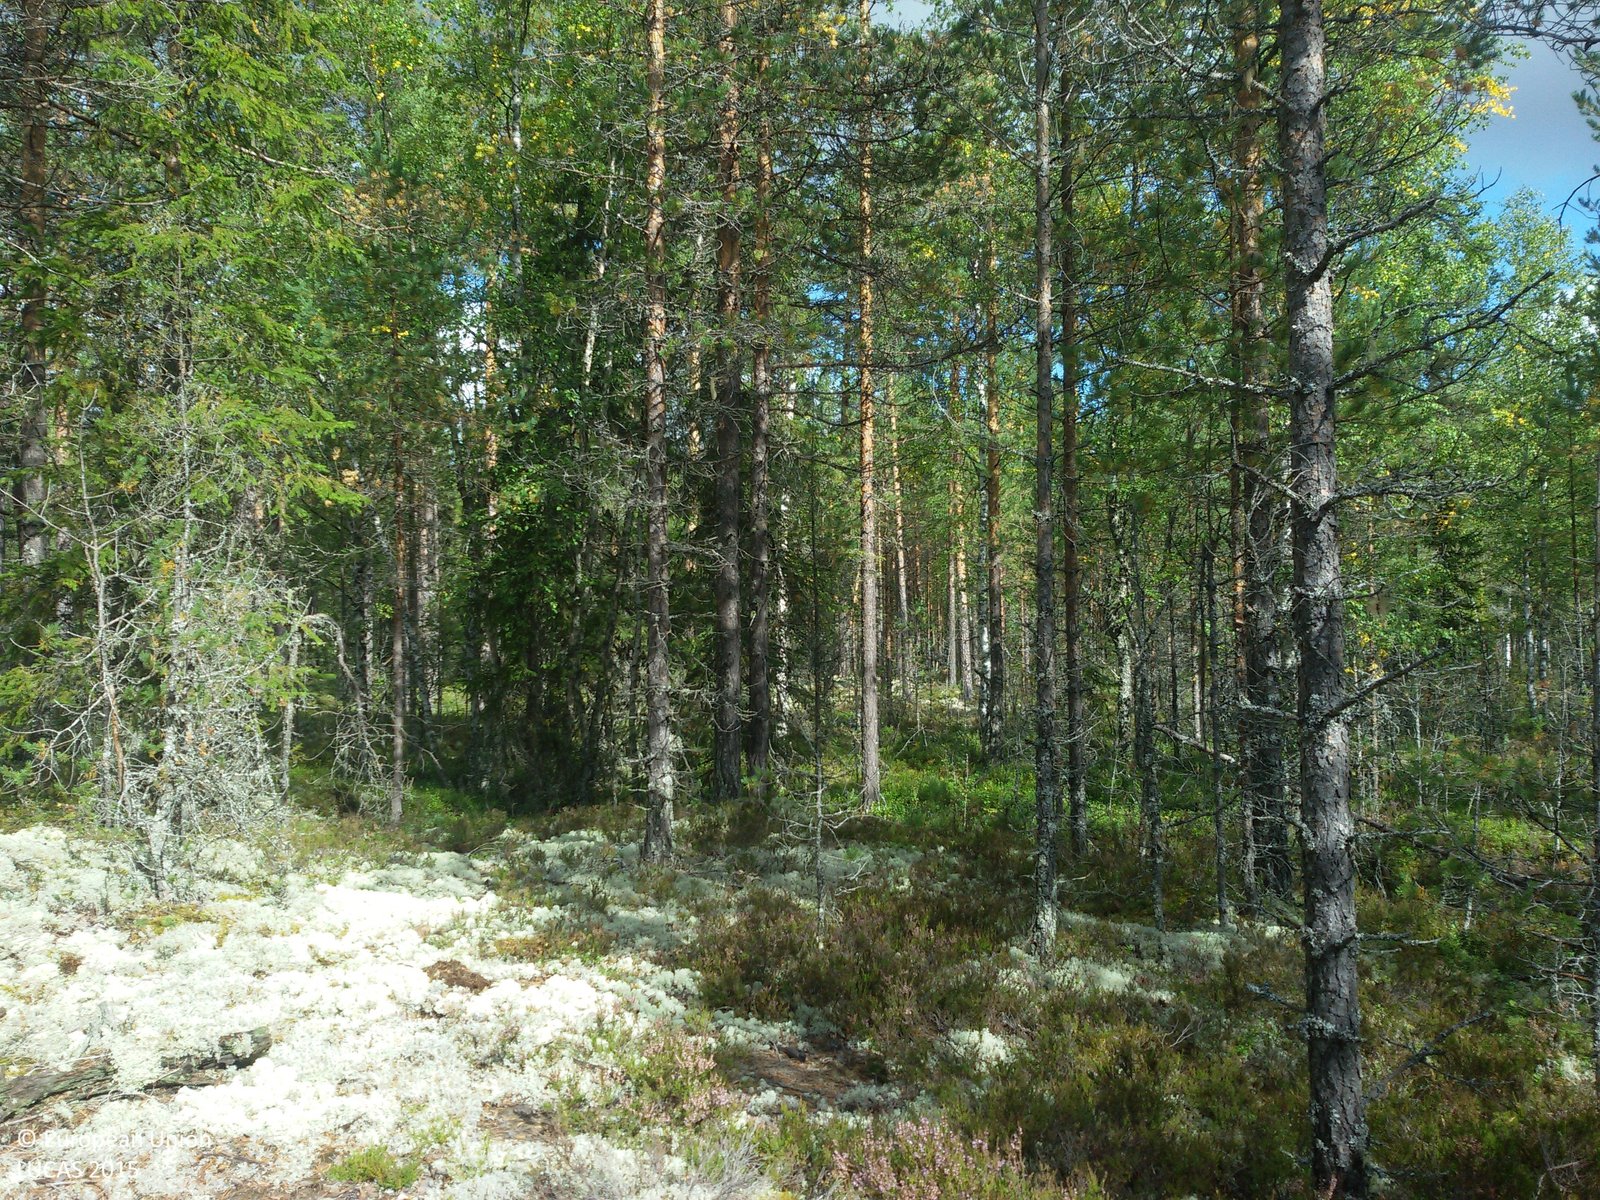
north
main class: Woodland
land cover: Pine dominated coniferous woodland
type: boreal forest
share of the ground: 50 - 75 %
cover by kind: coniferous forest trees 70 %, shrubs 15 %, lichens and mosses 15 %
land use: Forestry
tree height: > 5 m
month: September
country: SE
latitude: 61.0310
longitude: 15.4829
